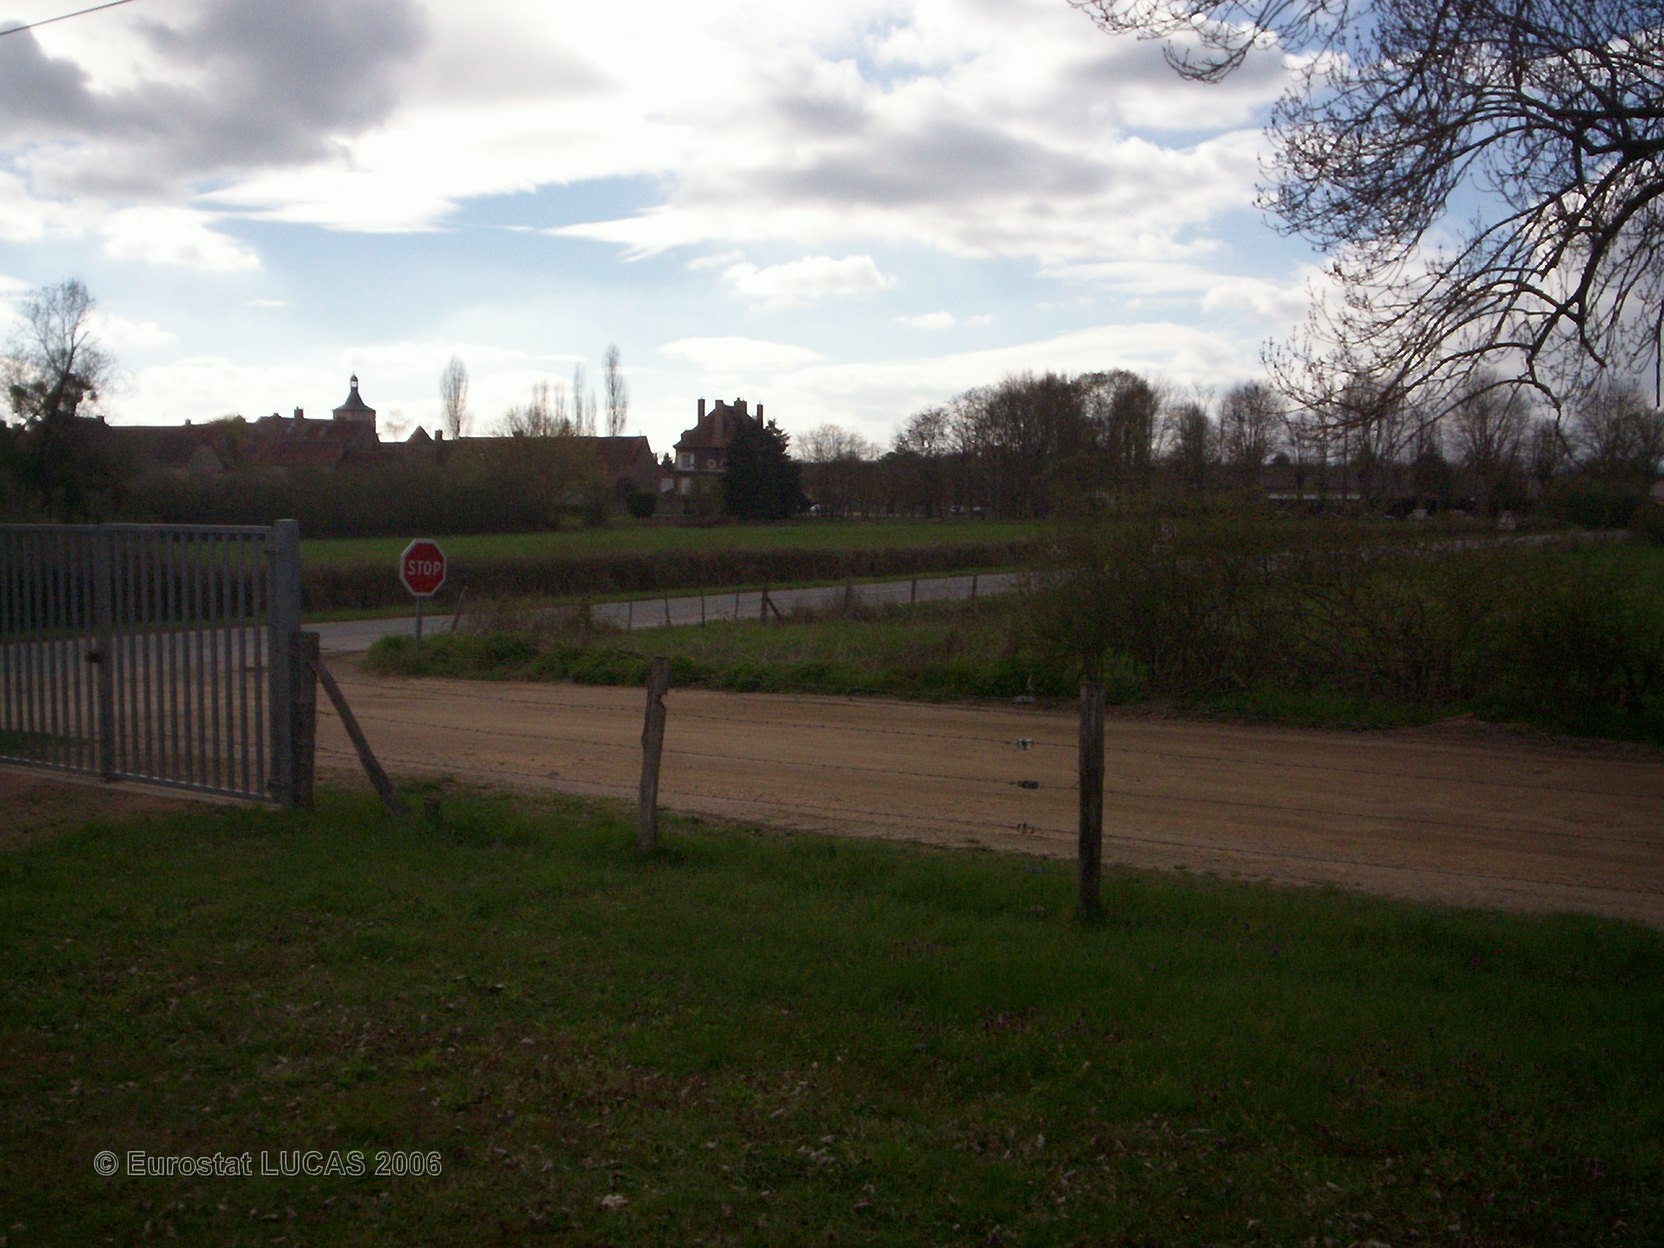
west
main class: Grassland
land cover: Grassland without tree/shrub cover
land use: Community services
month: April
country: FR
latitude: 46.7573
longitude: 3.0447
